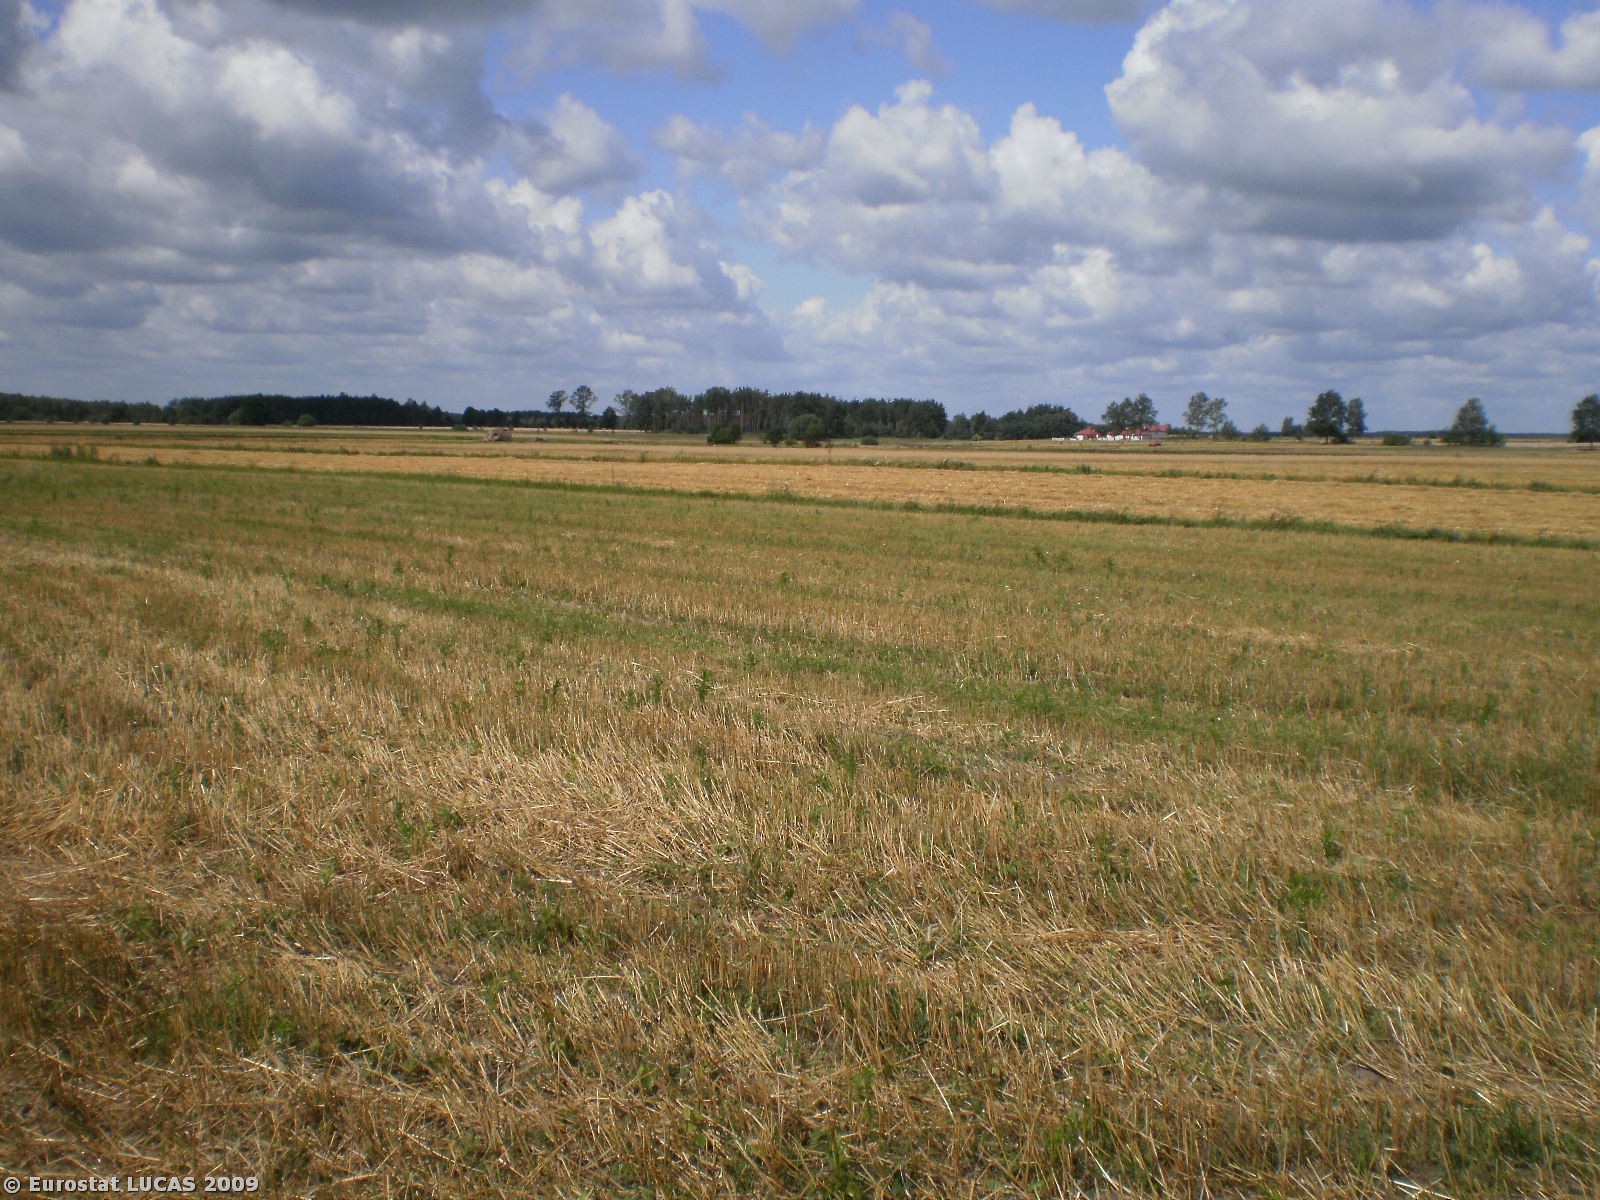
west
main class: Cropland
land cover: Rye
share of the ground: < 10 %
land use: Agriculture (excluding fallow land and kitchen gardens)
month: August
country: PL
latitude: 53.2155
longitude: 21.8713
